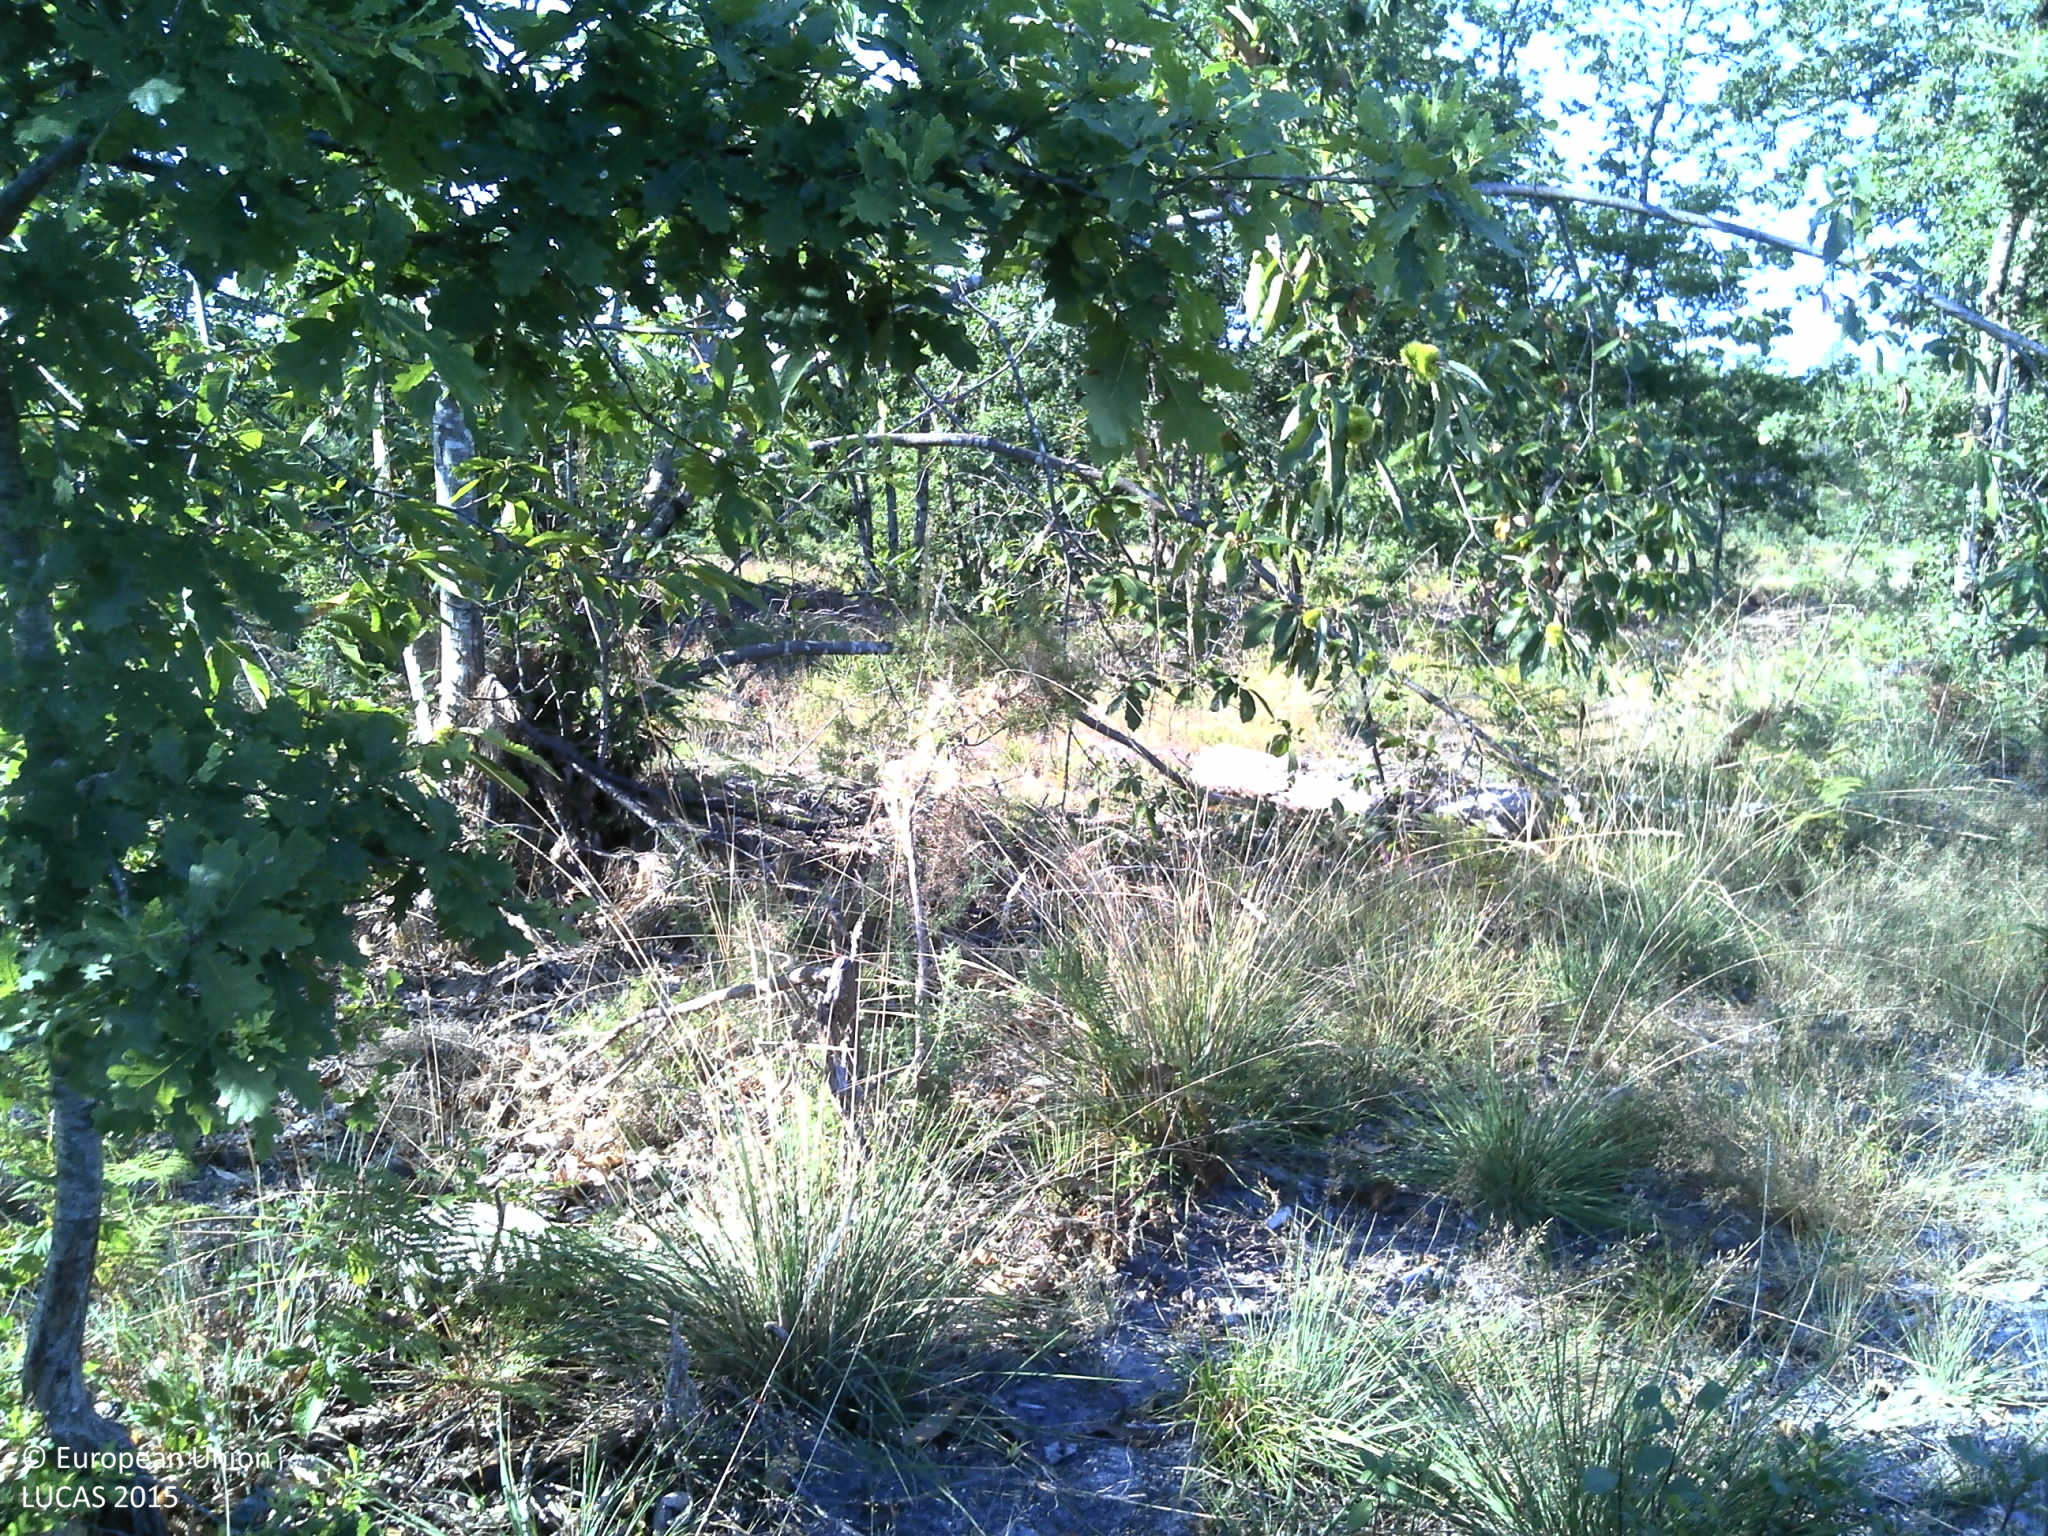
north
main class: Woodland
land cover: Pine dominated mixed woodland
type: coniferous forest of the mediterranean region
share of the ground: 50 - 75 %
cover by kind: broadleaved forest trees 50 %, coniferous forest trees 25 %, shrubs 15 %, herbaceous plants 5 %, lichens and mosses 5 %
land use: Forestry
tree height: < 5 m
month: August
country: FR
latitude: 44.5051
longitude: -0.6964
